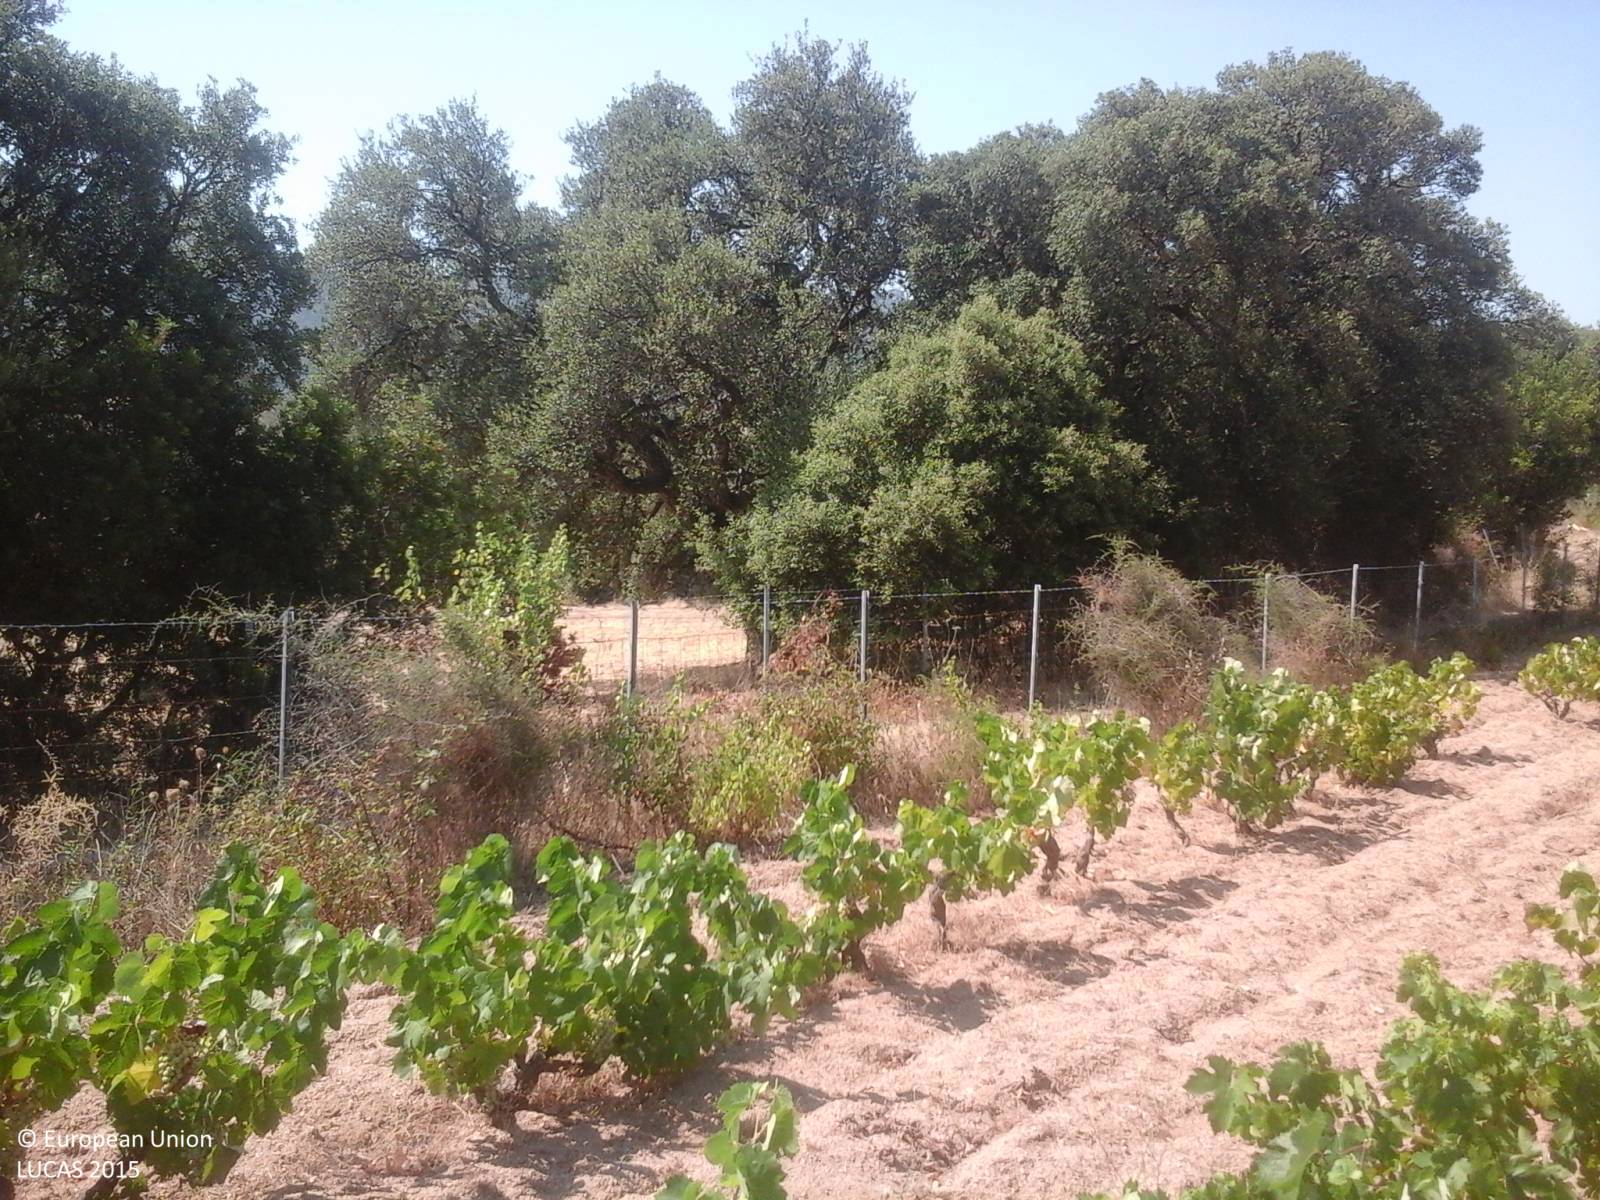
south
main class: Cropland
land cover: Vineyards
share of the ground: > 75 %
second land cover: Other bare soil
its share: > 75 %
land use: Agriculture (excluding fallow land and kitchen gardens)
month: July
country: IT
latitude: 40.8446
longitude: 9.3980
